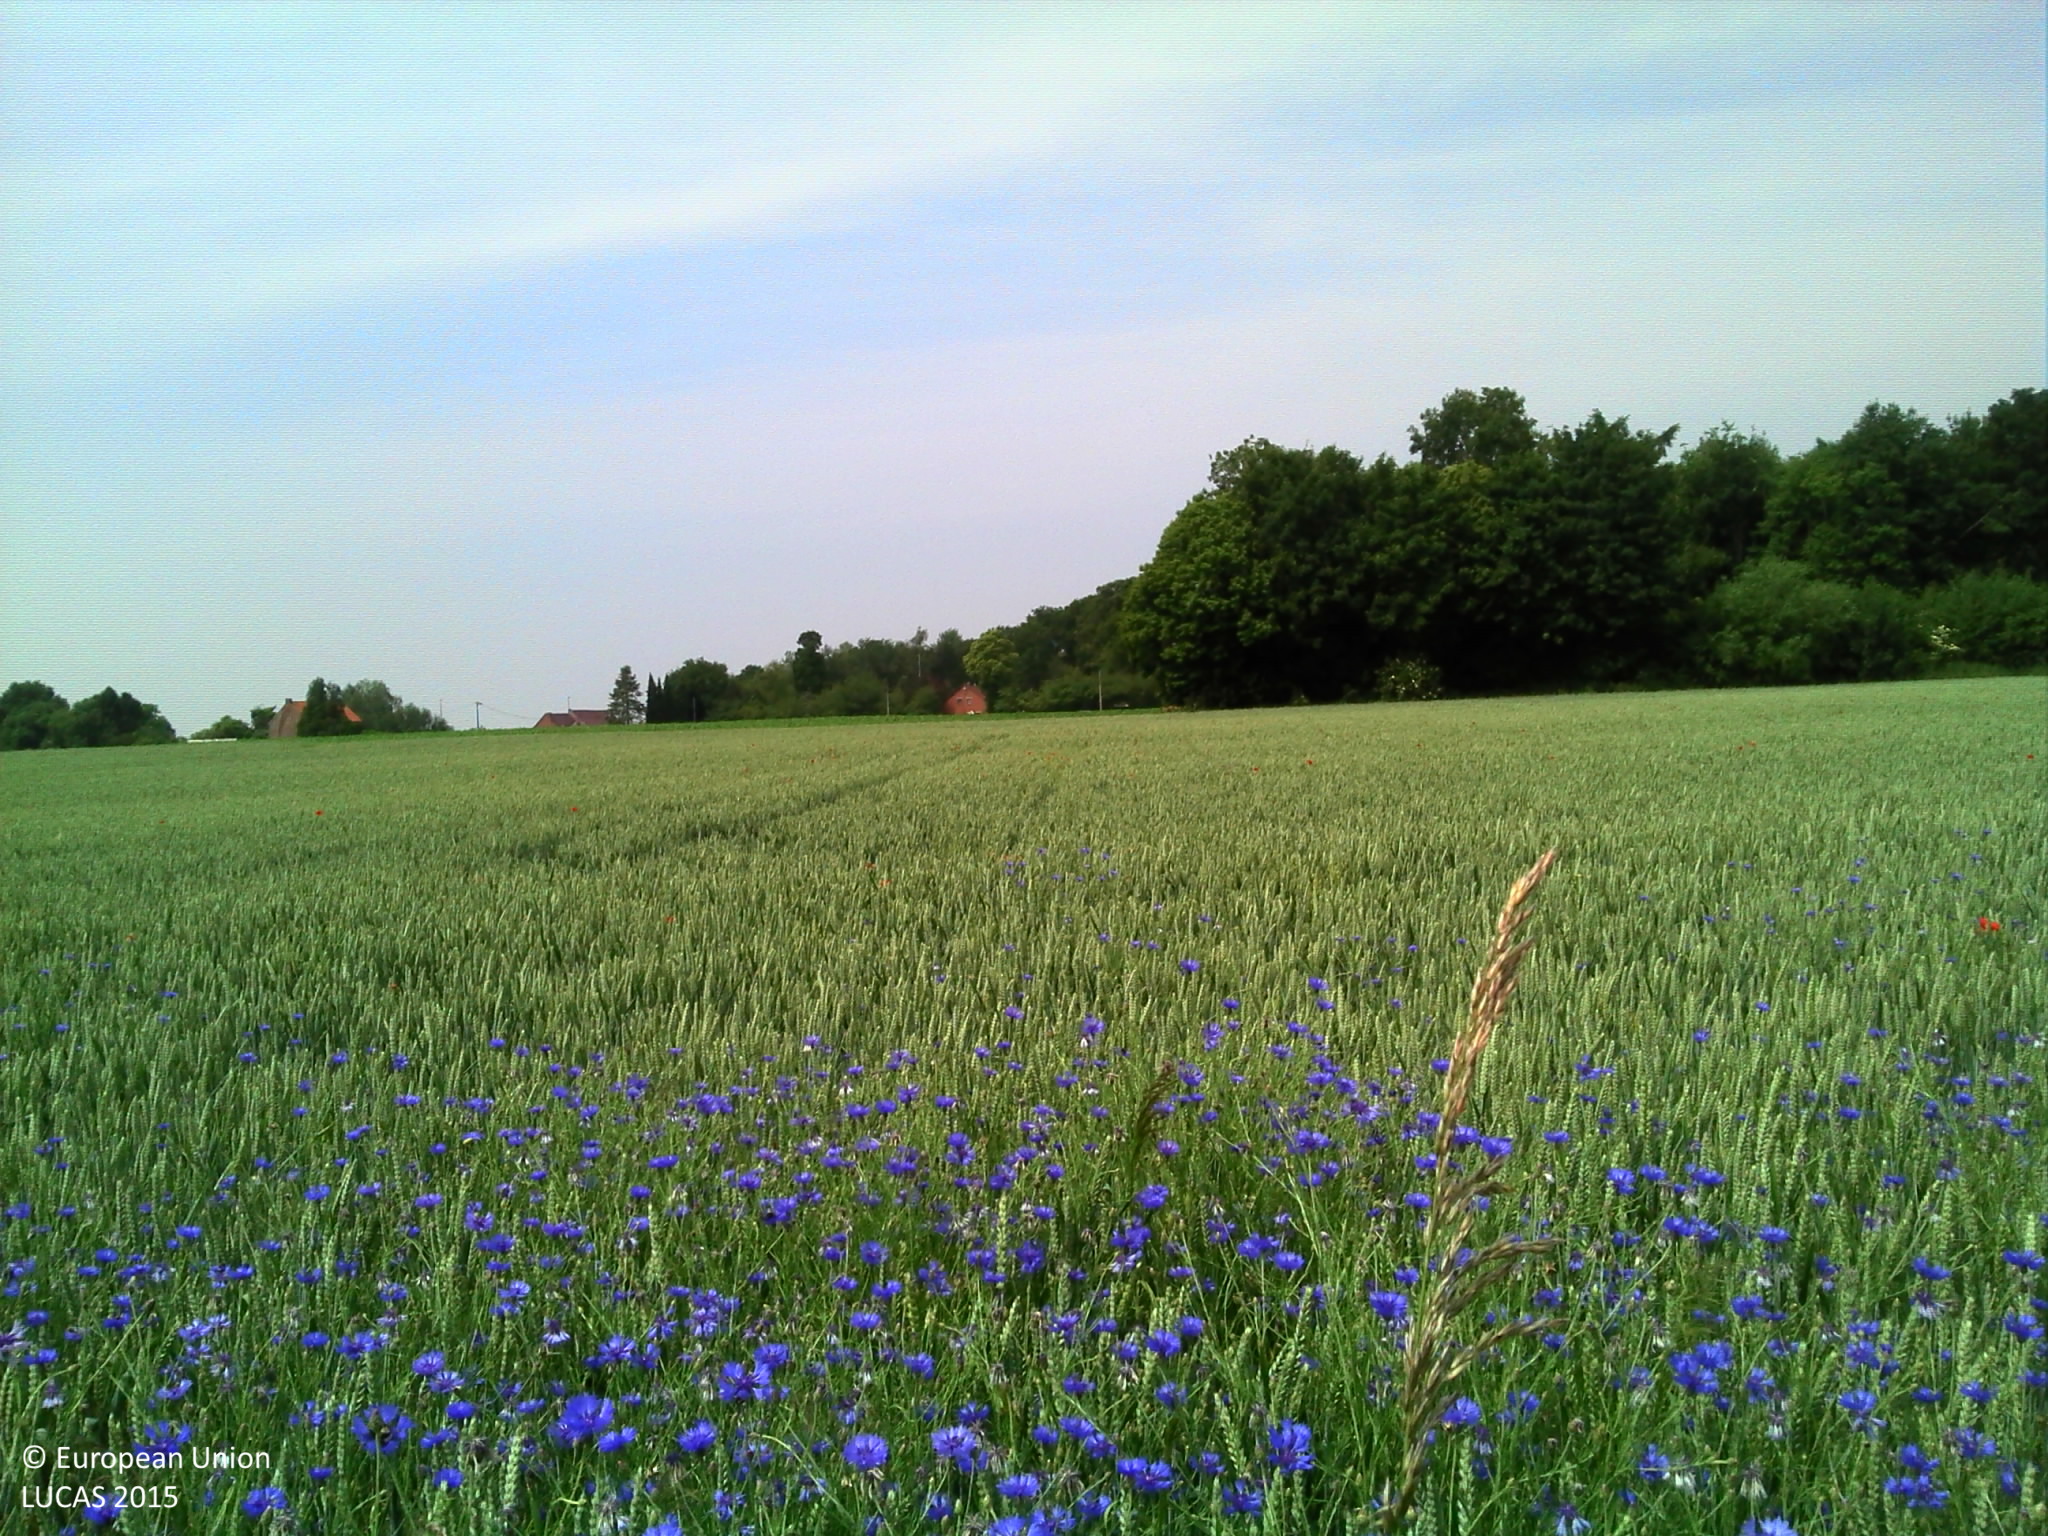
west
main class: Grassland
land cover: Grassland with sparse tree/shrub cover
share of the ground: > 75 %
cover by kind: herbaceous plants 95 %, broadleaved forest trees 5 %
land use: Residential
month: June
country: BE
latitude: 50.4817
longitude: 3.7502
